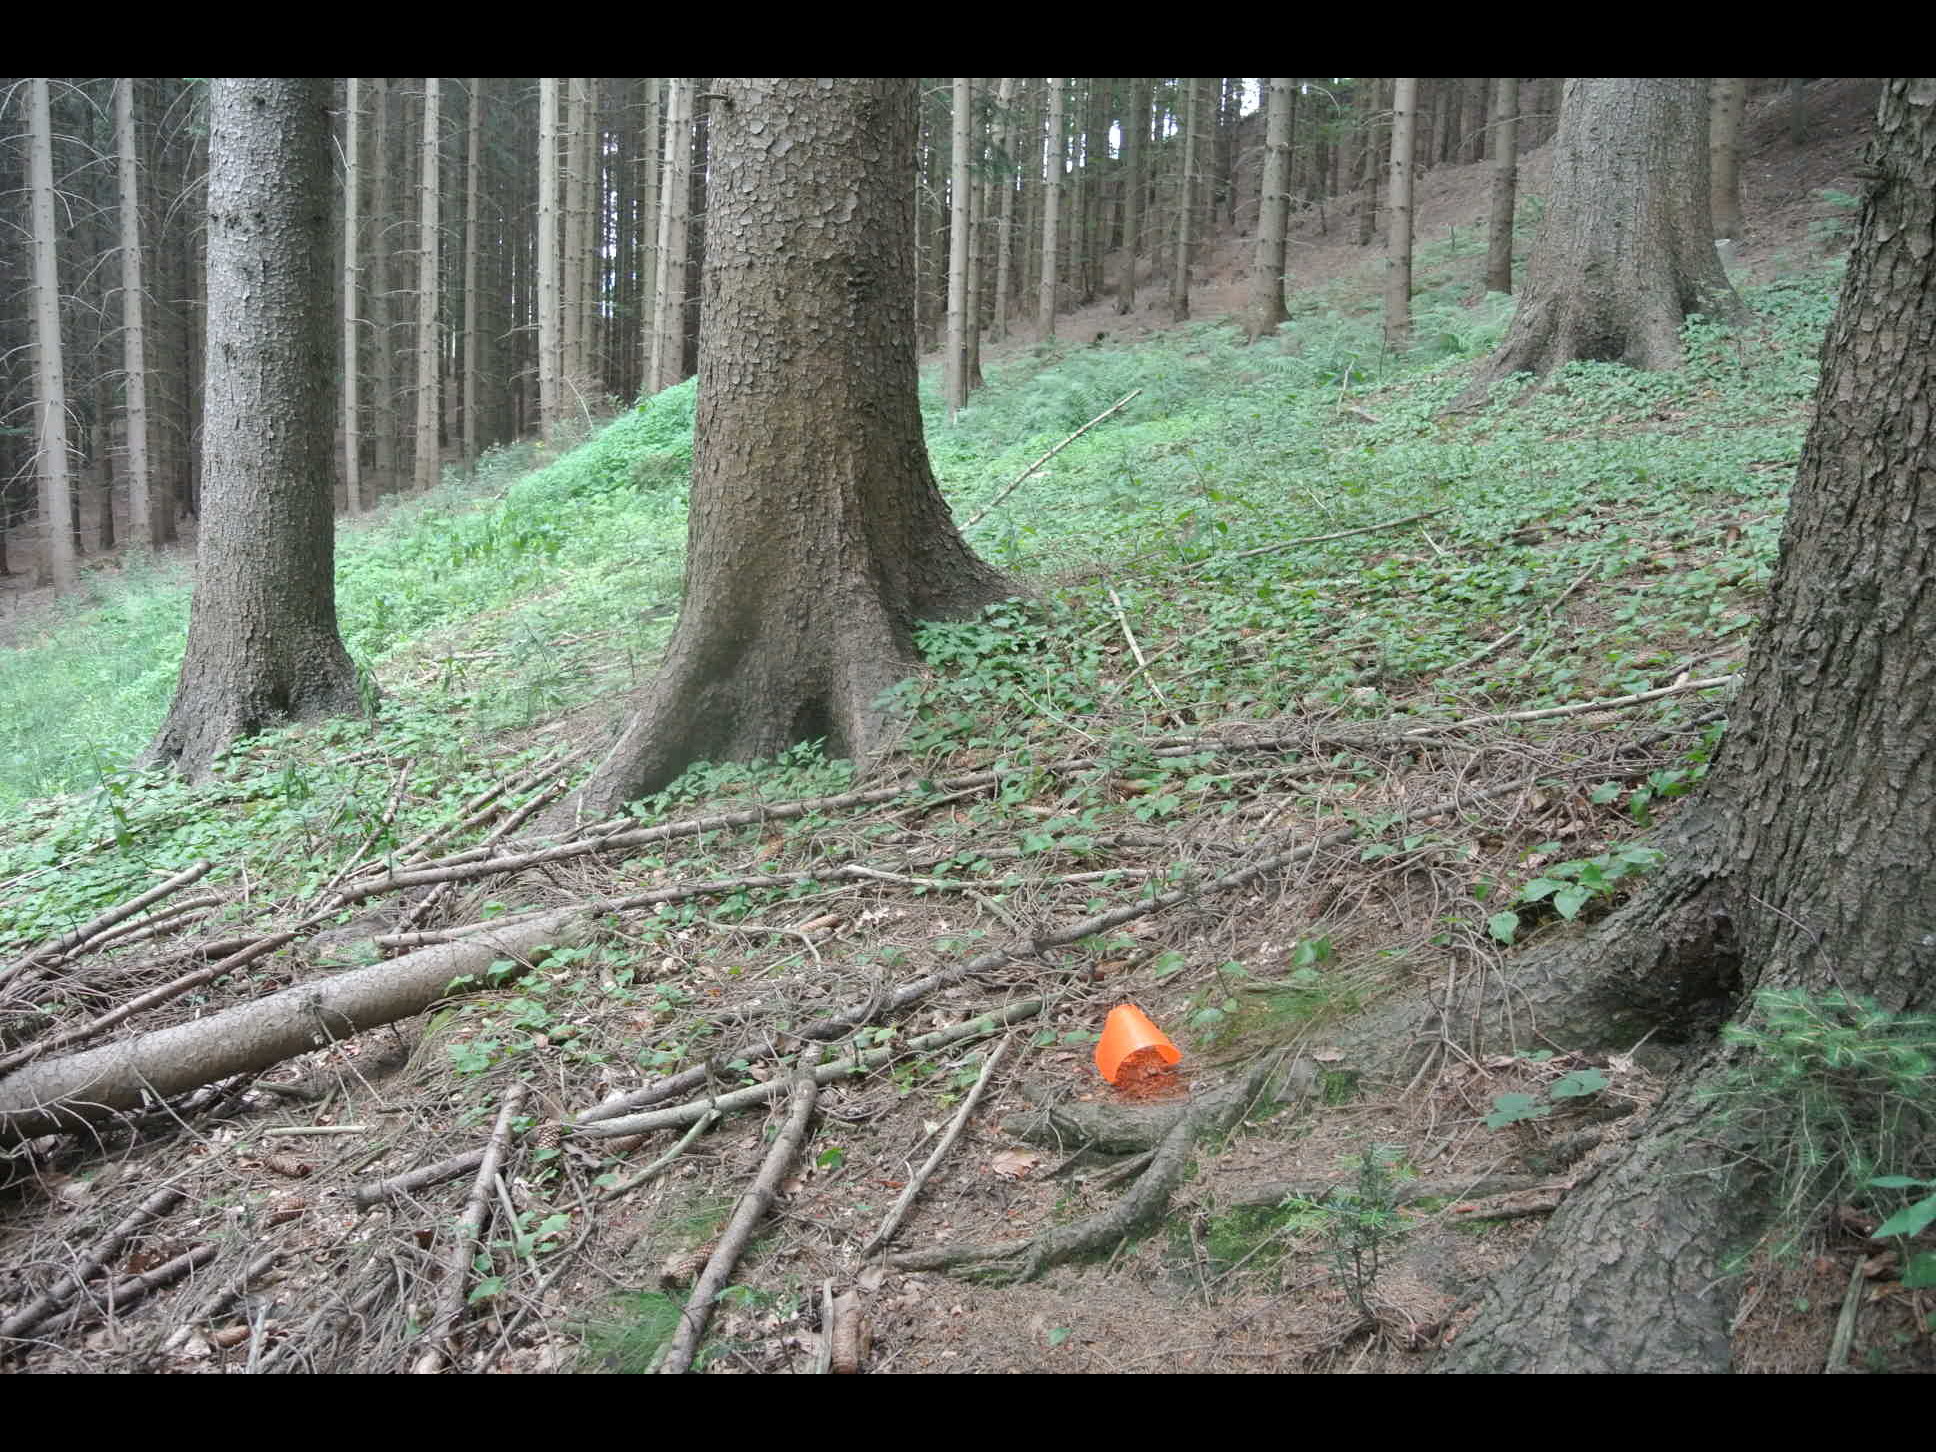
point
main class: Woodland
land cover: Spruce dominated coniferous woodland
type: alpine coniferous forest
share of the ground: > 75 %
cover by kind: coniferous forest trees 70 %, broadleaved forest trees 20 %, herbaceous plants 10 %
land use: Forestry
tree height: > 5 m
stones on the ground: < 10 %
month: July
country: AT
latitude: 47.5656
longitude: 16.1302
